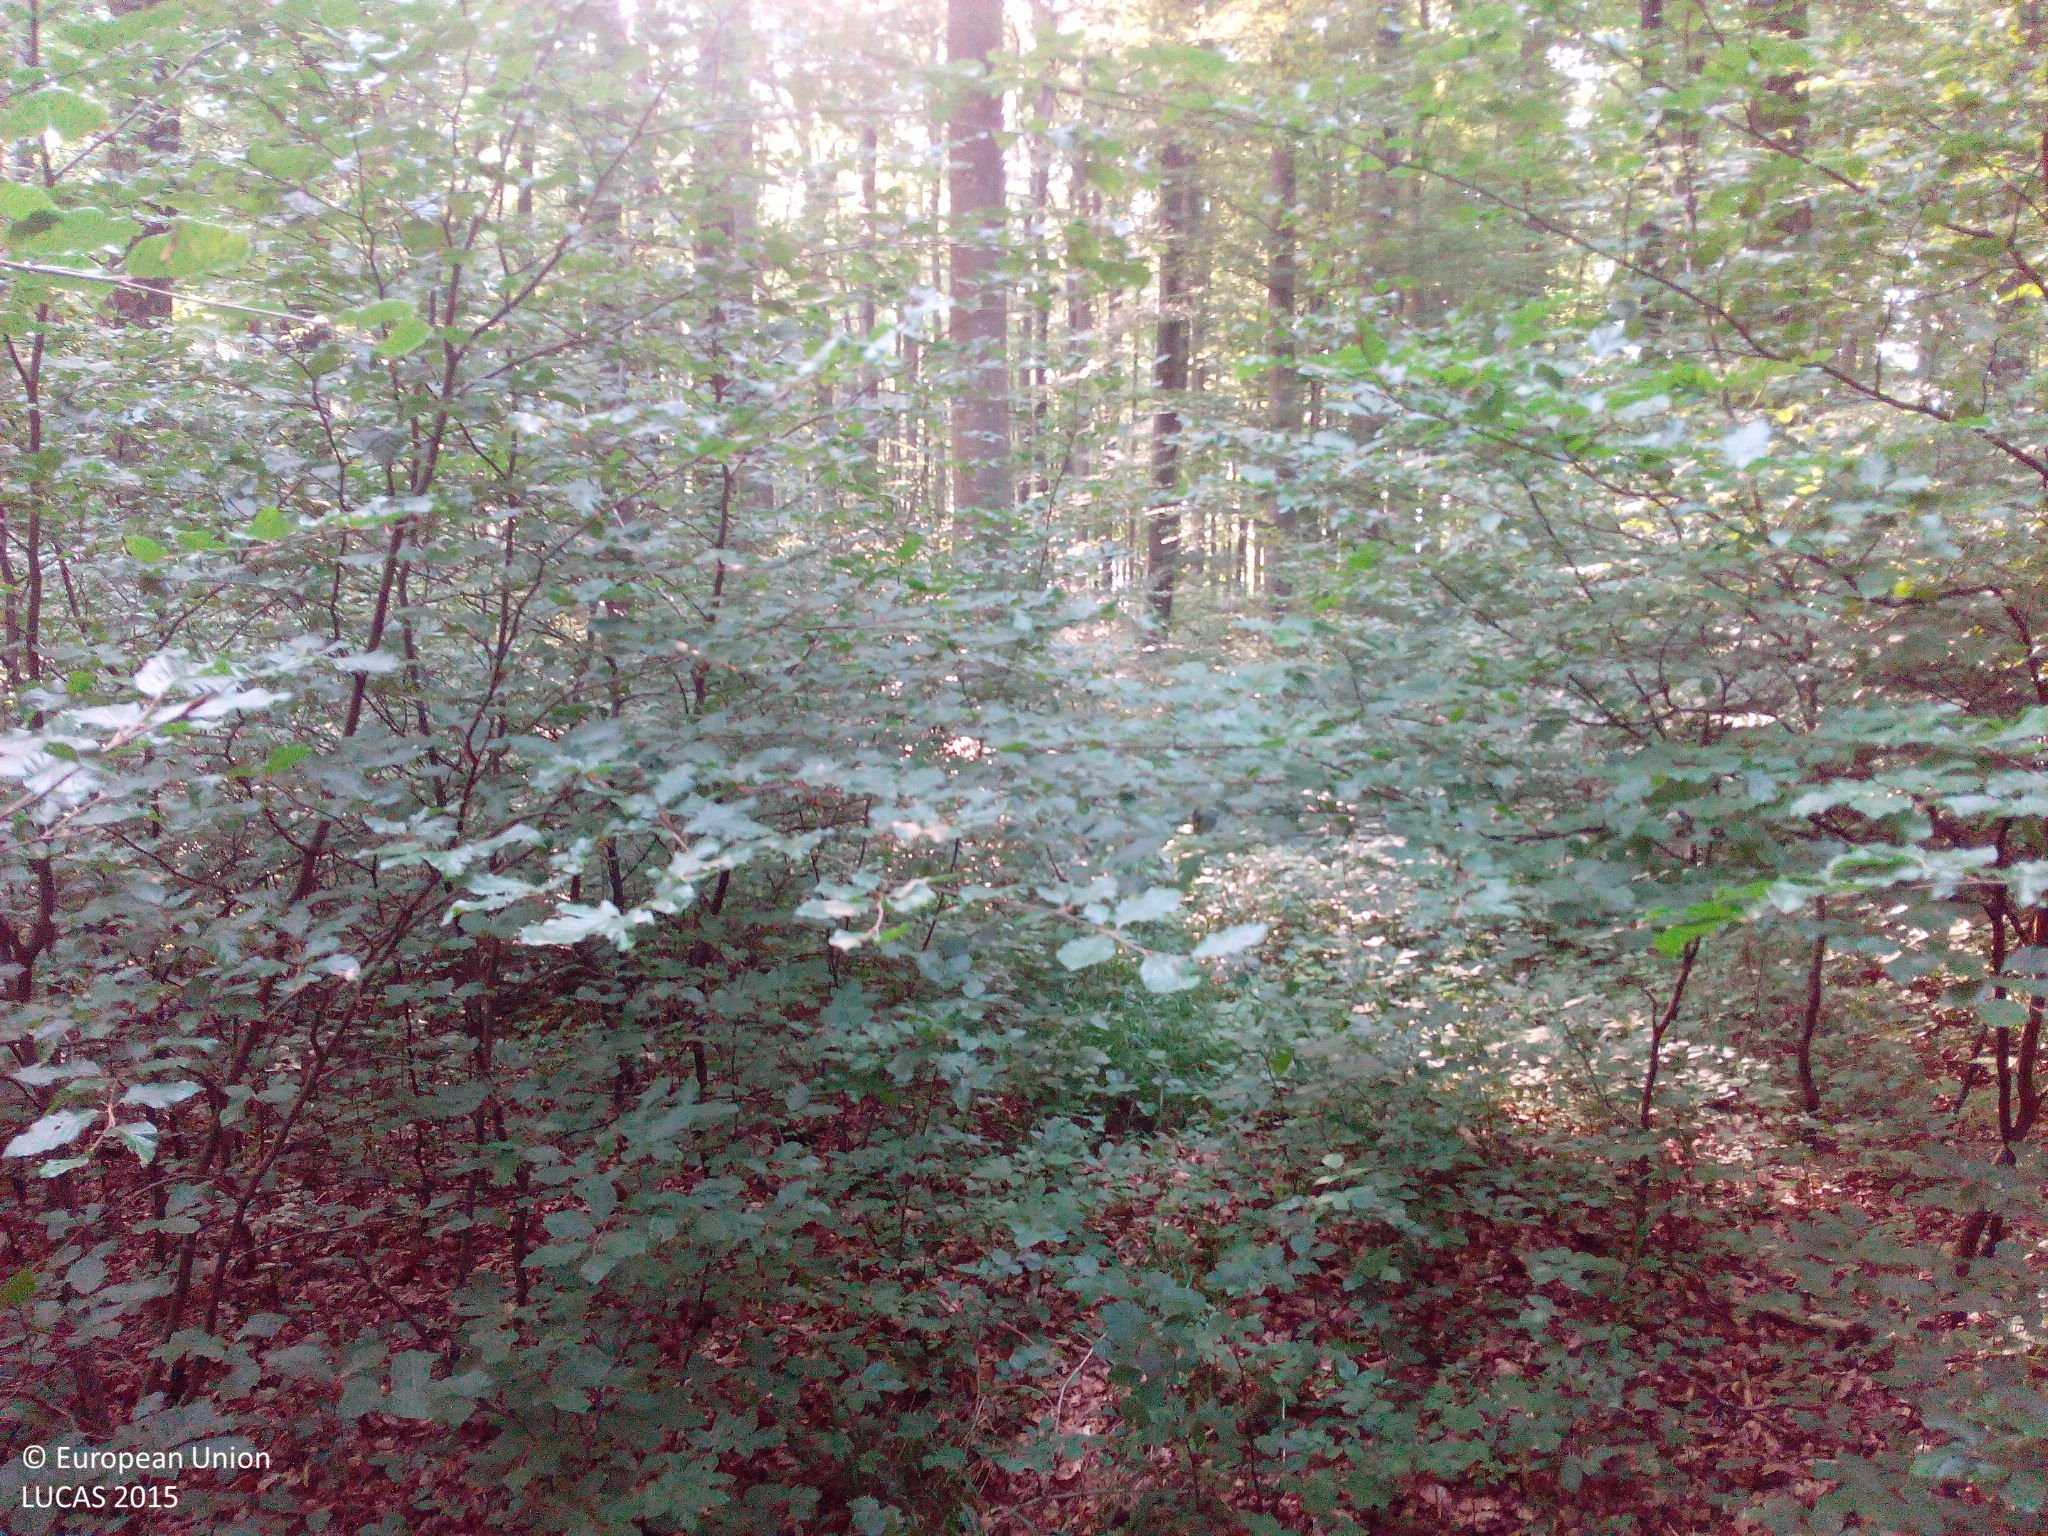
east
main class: Woodland
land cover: Broadleaved woodland
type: mesophytic deciduous forest
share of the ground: > 75 %
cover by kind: broadleaved forest trees 95 %, unconsolidated bare surface 5 %
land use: Forestry
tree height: > 5 m
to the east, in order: Broadleaved woodland
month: July
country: DE
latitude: 48.1494
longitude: 9.3149
